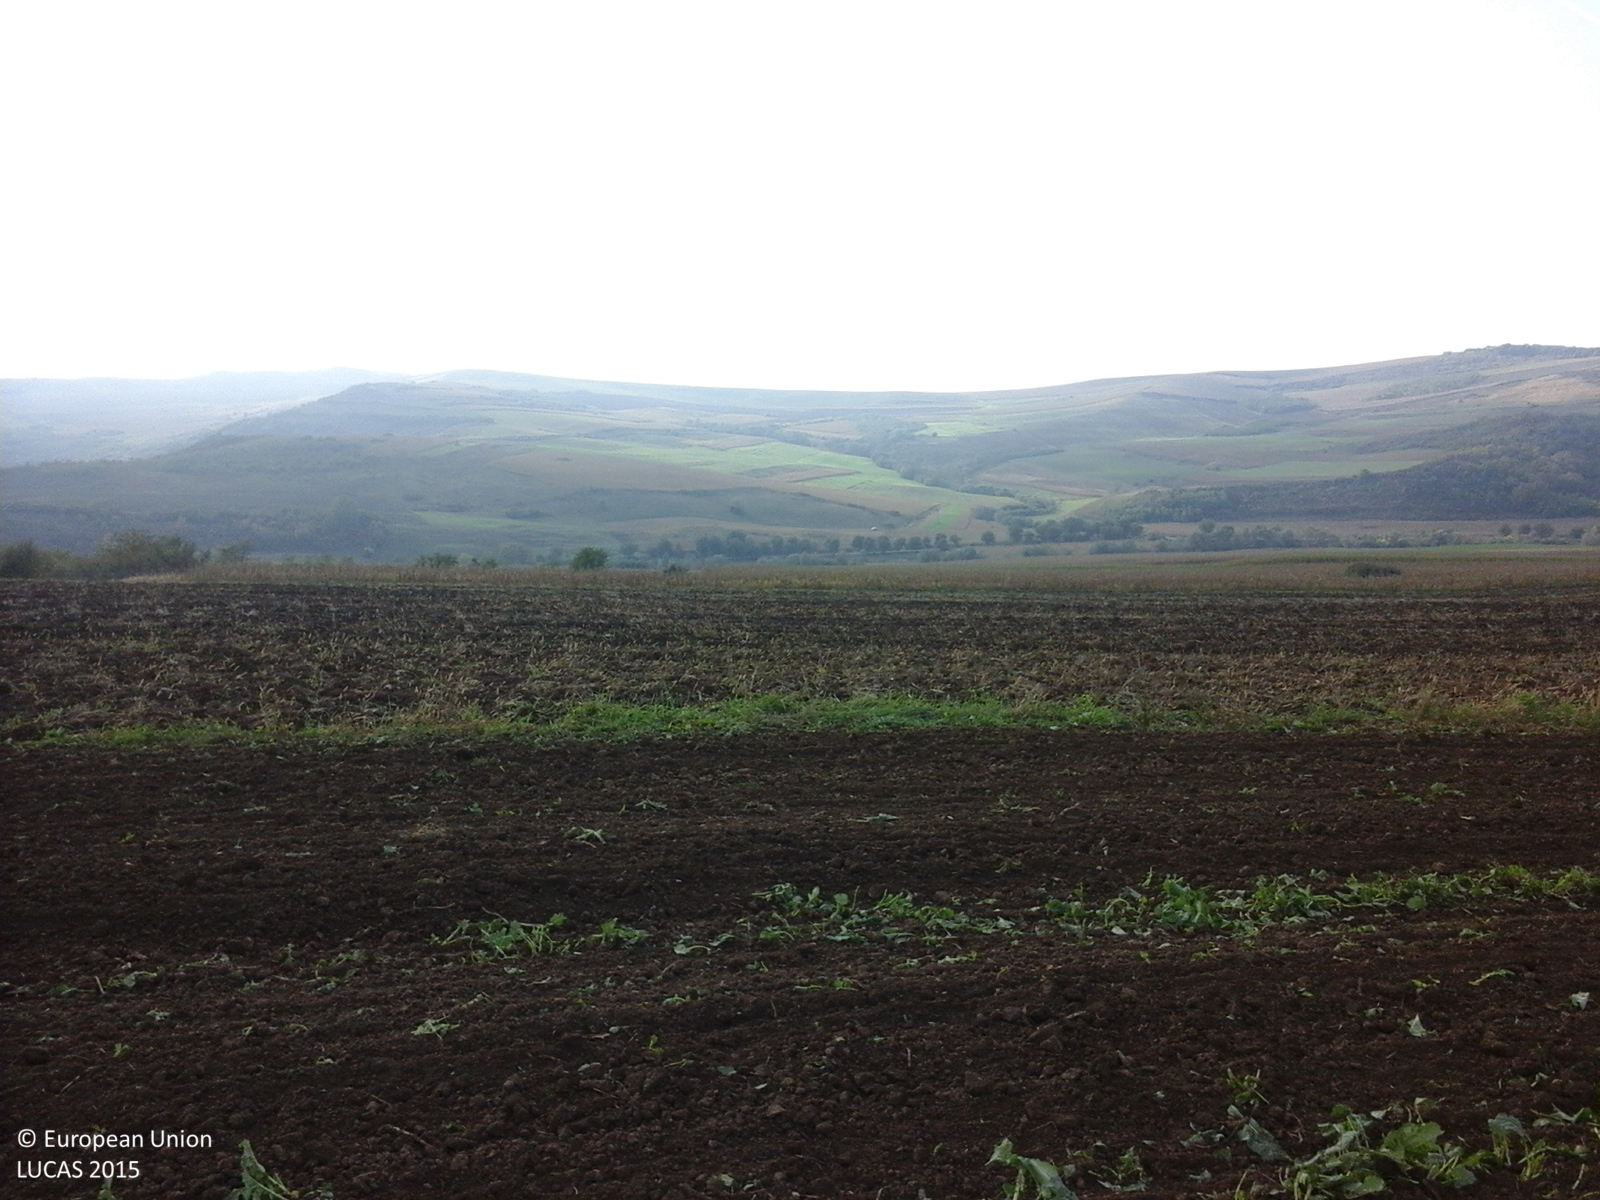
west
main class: Cropland
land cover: Common wheat
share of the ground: < 10 %
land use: Agriculture (excluding fallow land and kitchen gardens)
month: October
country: RO
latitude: 46.4785
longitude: 24.3194
